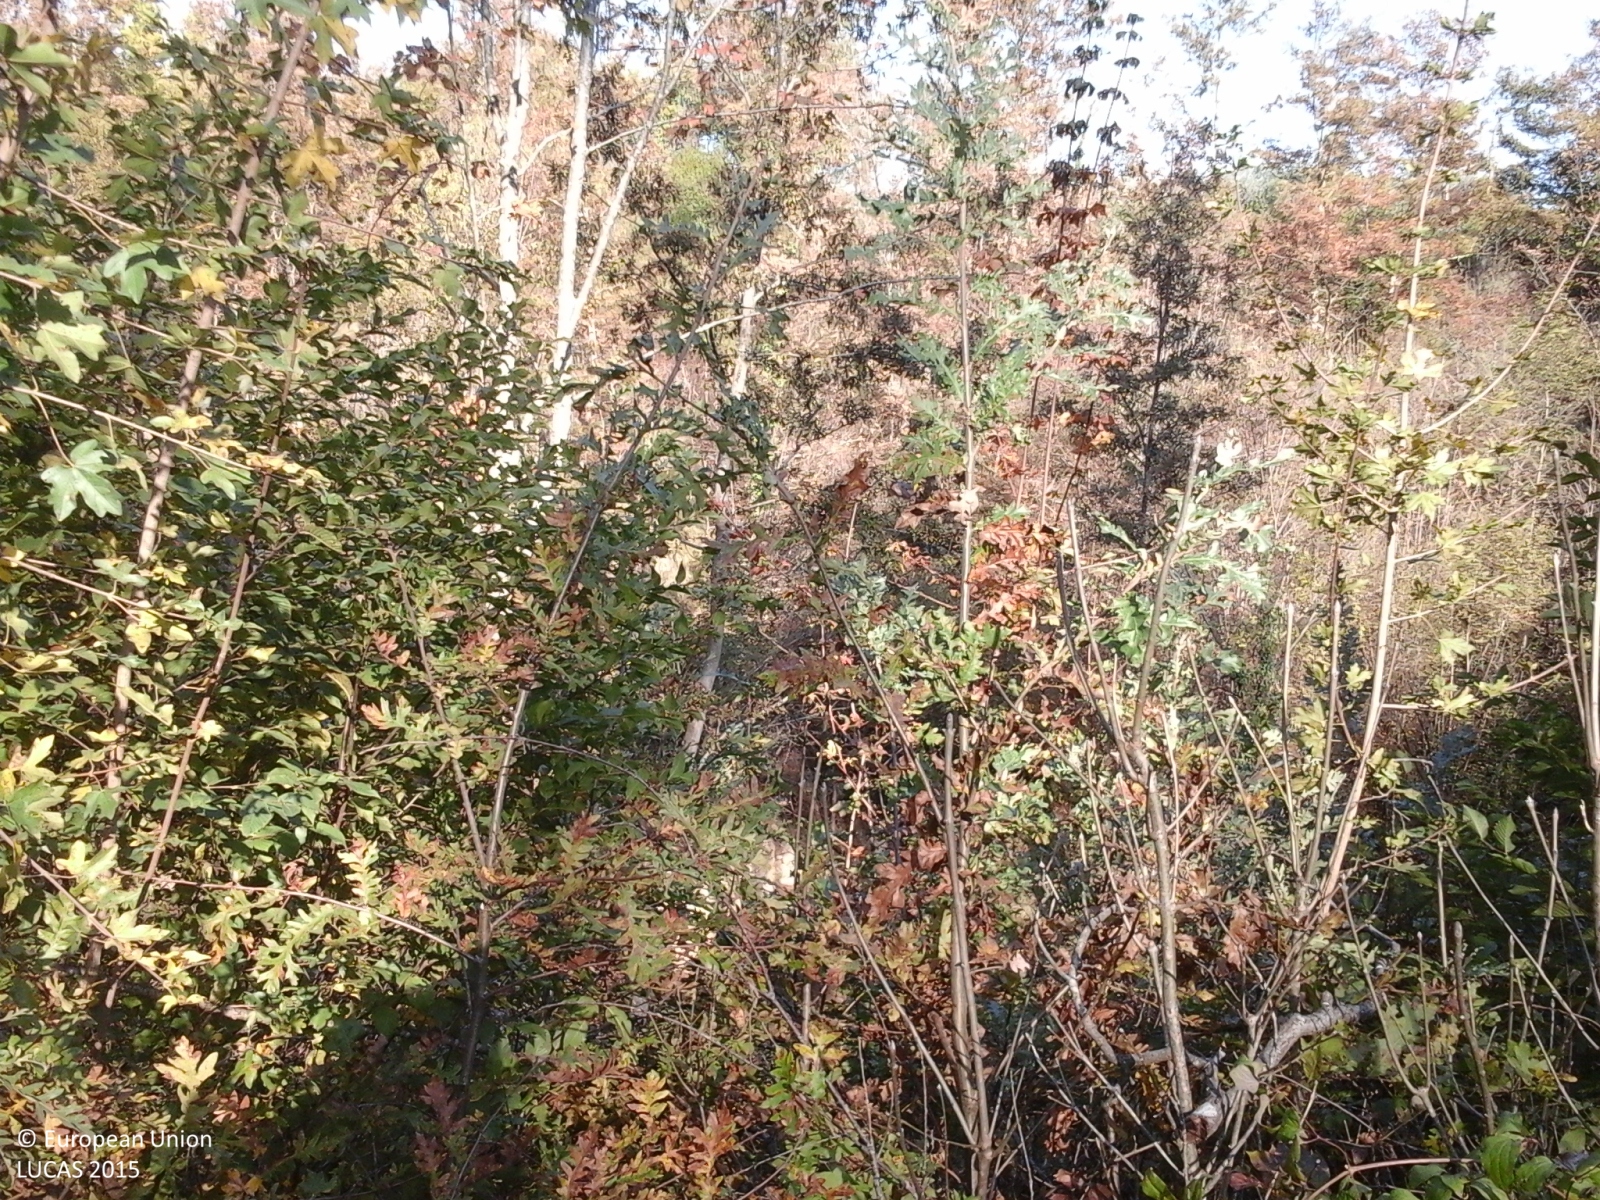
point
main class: Woodland
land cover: Broadleaved woodland
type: mesophytic deciduous forest
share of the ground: > 75 %
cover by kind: broadleaved forest trees 100 %
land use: Forestry
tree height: > 5 m
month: August
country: IT
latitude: 43.1360
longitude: 11.0663
